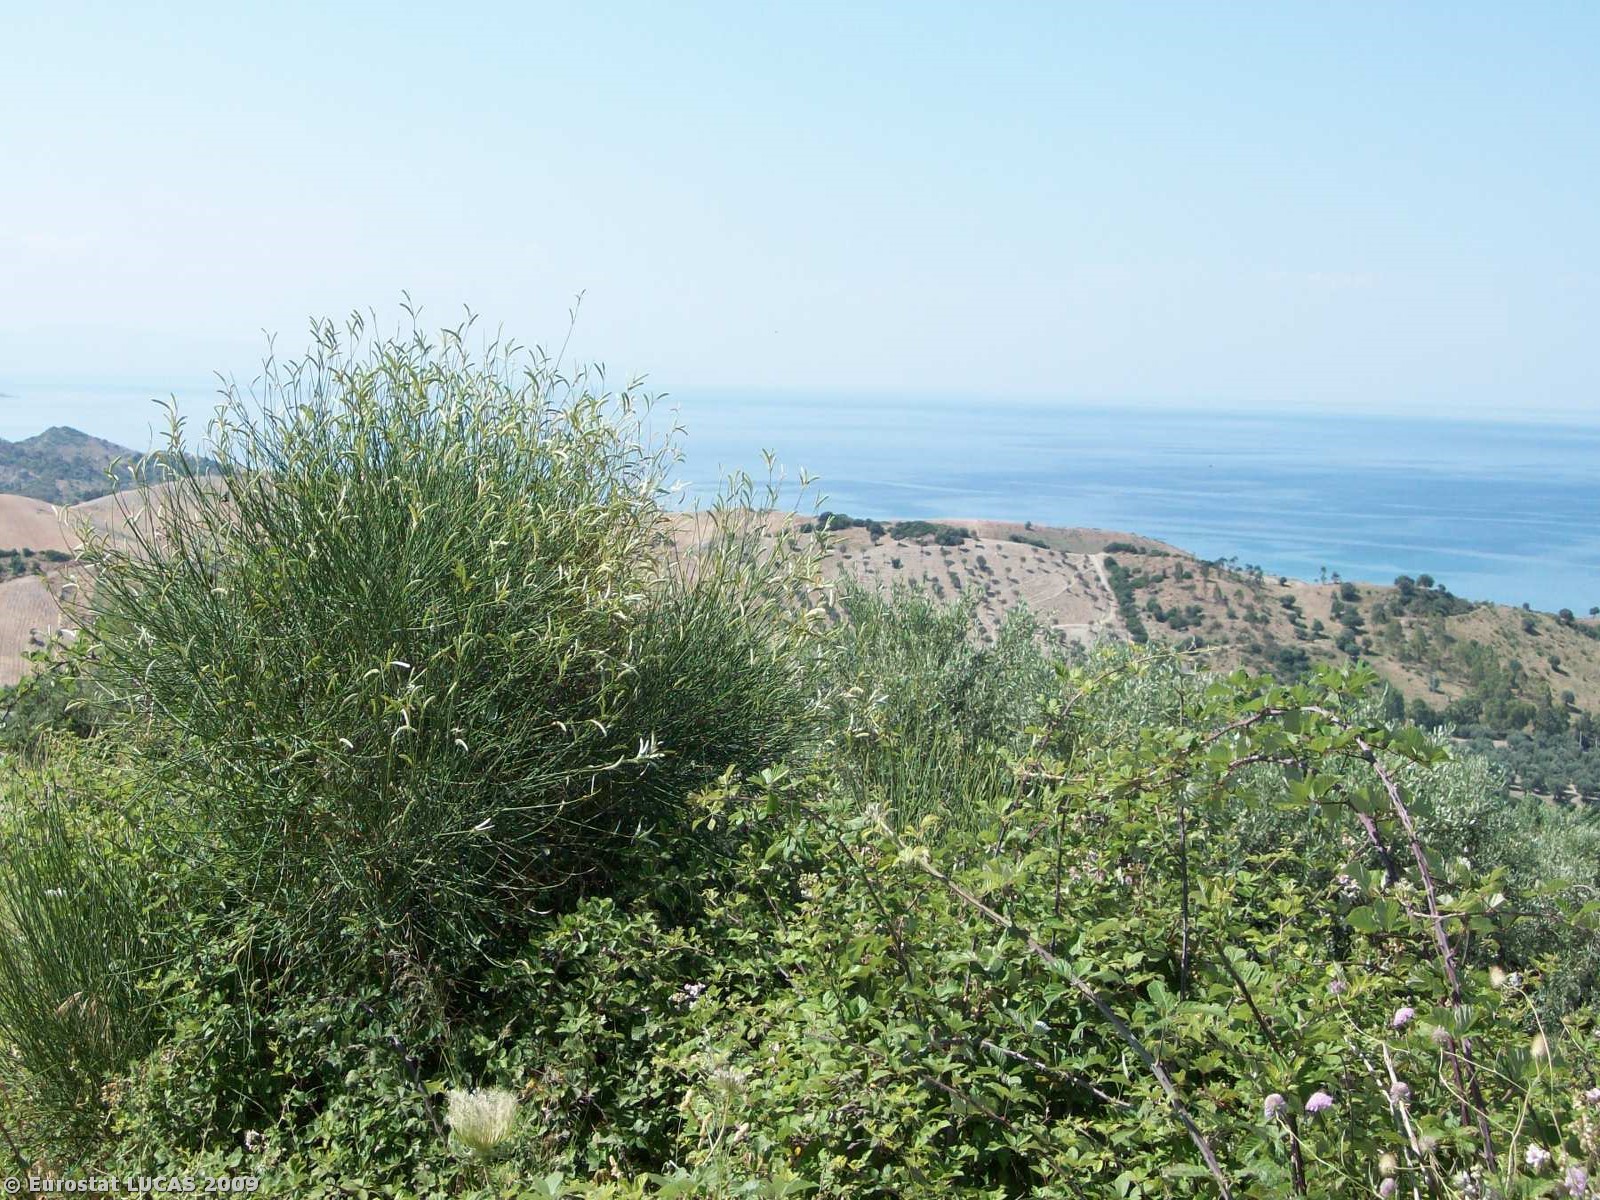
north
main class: Shrubland
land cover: Shrubland with sparse tree cover
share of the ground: > 75 %
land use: Unused
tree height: > 5 m
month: June
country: IT
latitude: 39.4966
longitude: 16.9115
